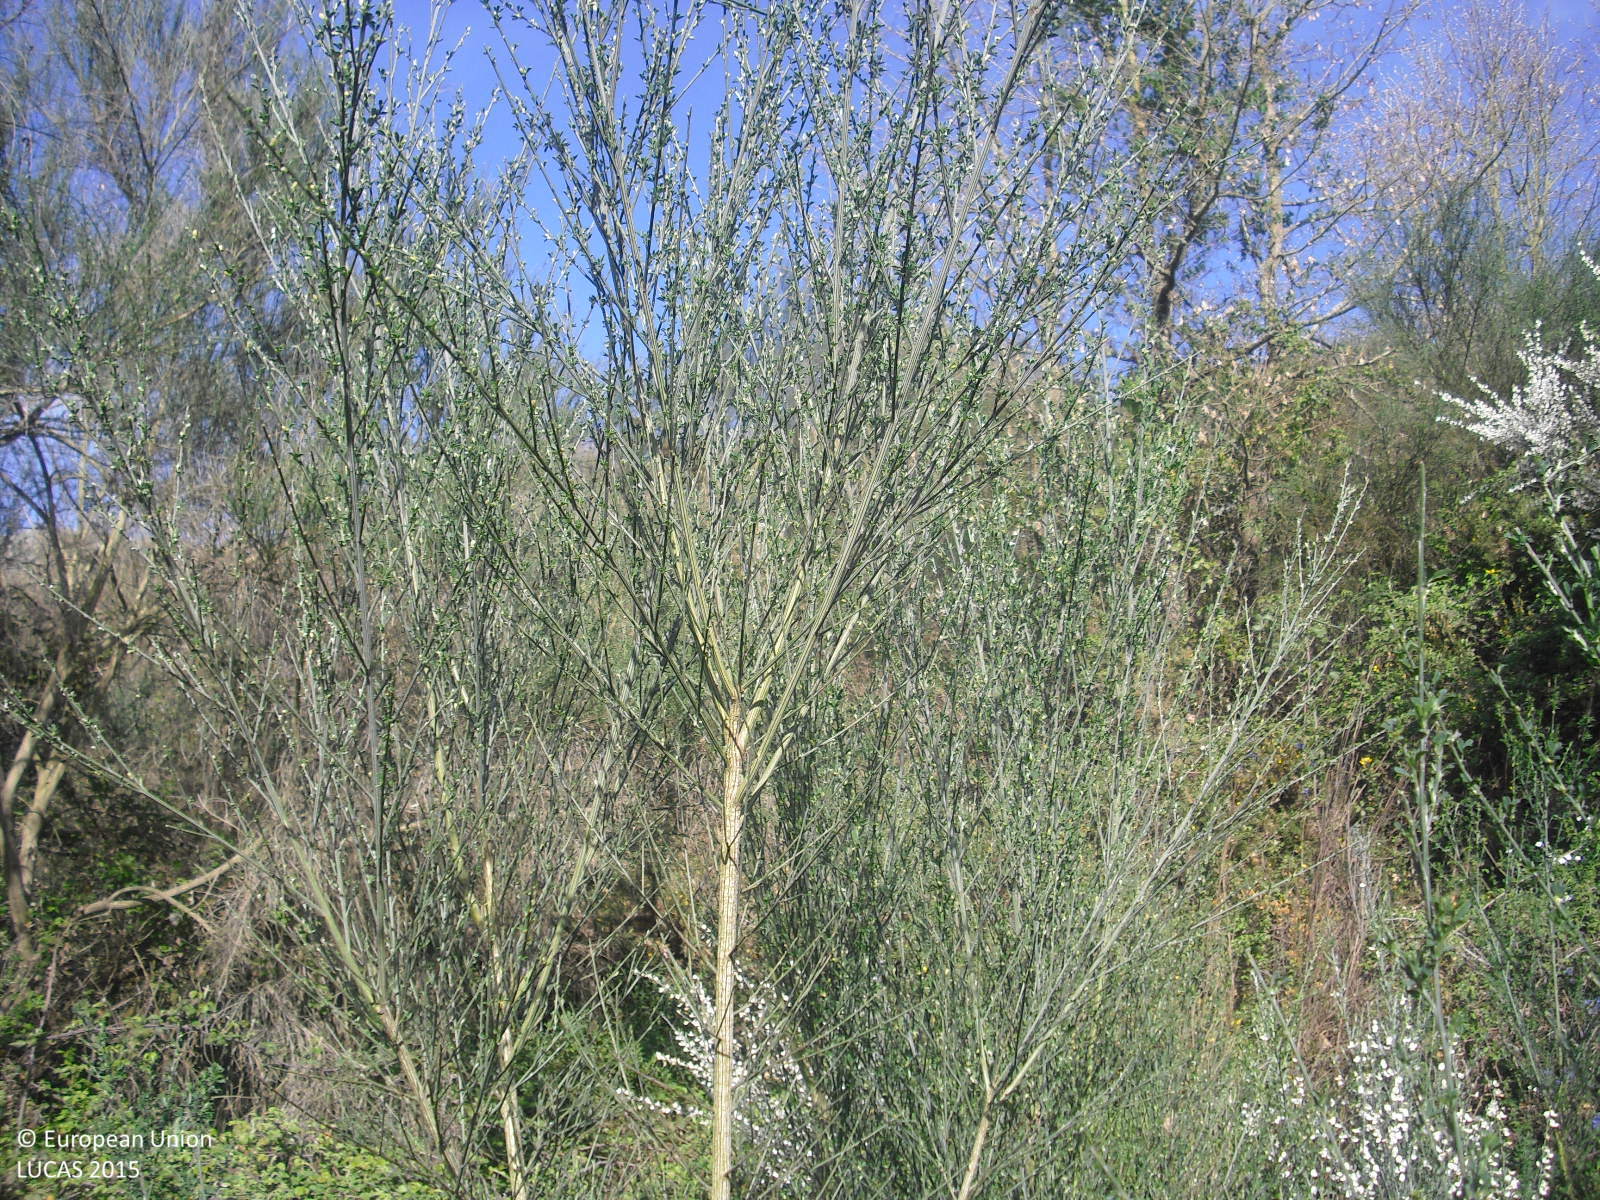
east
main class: Woodland
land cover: Broadleaved woodland
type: thermophilous deciduous forest
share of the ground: 50 - 75 %
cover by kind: broadleaved forest trees 60 %, shrubs 30 %, herbaceous plants 10 %
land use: Semi-natural and natural areas not in use
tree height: < 5 m
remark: Burnt area
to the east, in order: Broadleaved woodland; Shrubland with sparse tree cover; Broadleaved woodland; Dry stone walls; Broadleaved woodland; Shrubland with sparse tree cover; Shrubland without tree cover; Shrubland with sparse tree cover; Shrubland without tree cover
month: April
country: ES
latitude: 41.9924
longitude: -7.6545
